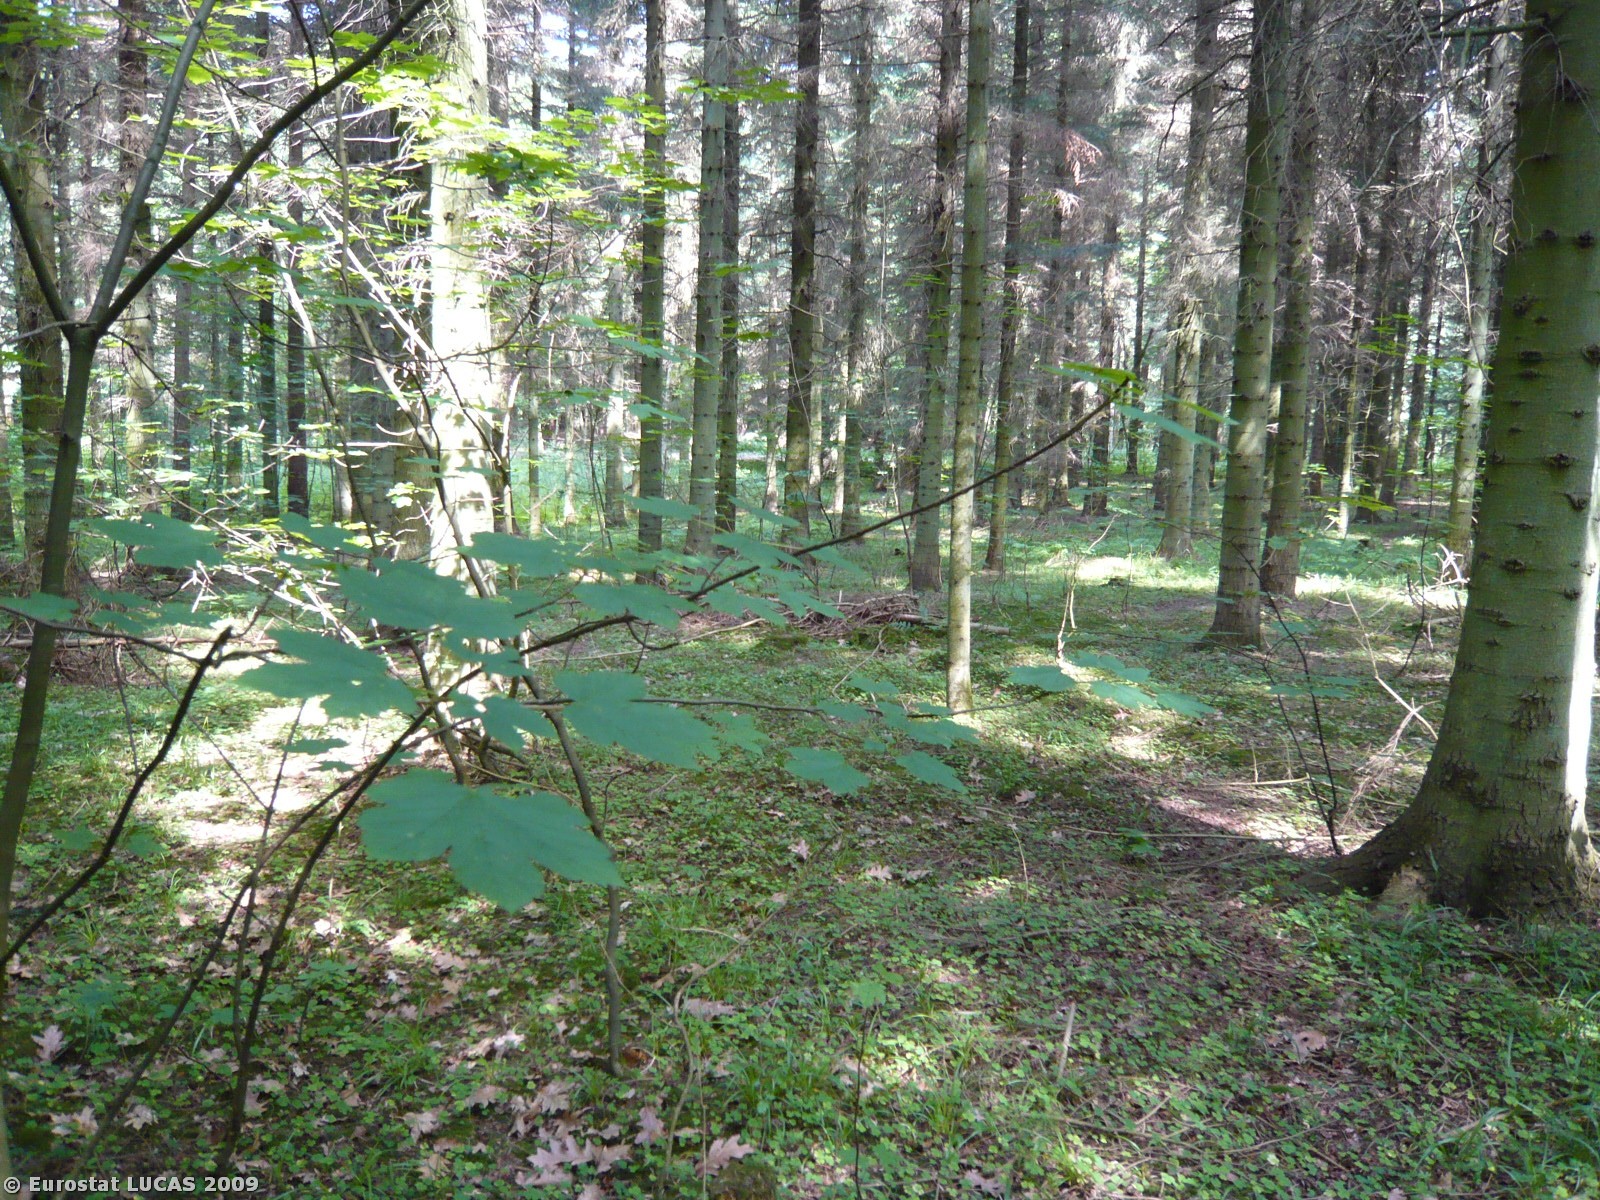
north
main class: Woodland
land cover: Coniferous woodland
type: hemiboreal forest and nemoral coniferous forest and mixed broadleaved-coniferous forest
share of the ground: > 75 %
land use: Forestry
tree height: > 5 m
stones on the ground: < 10 %
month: July
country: DK
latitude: 55.5451
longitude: 11.8527
